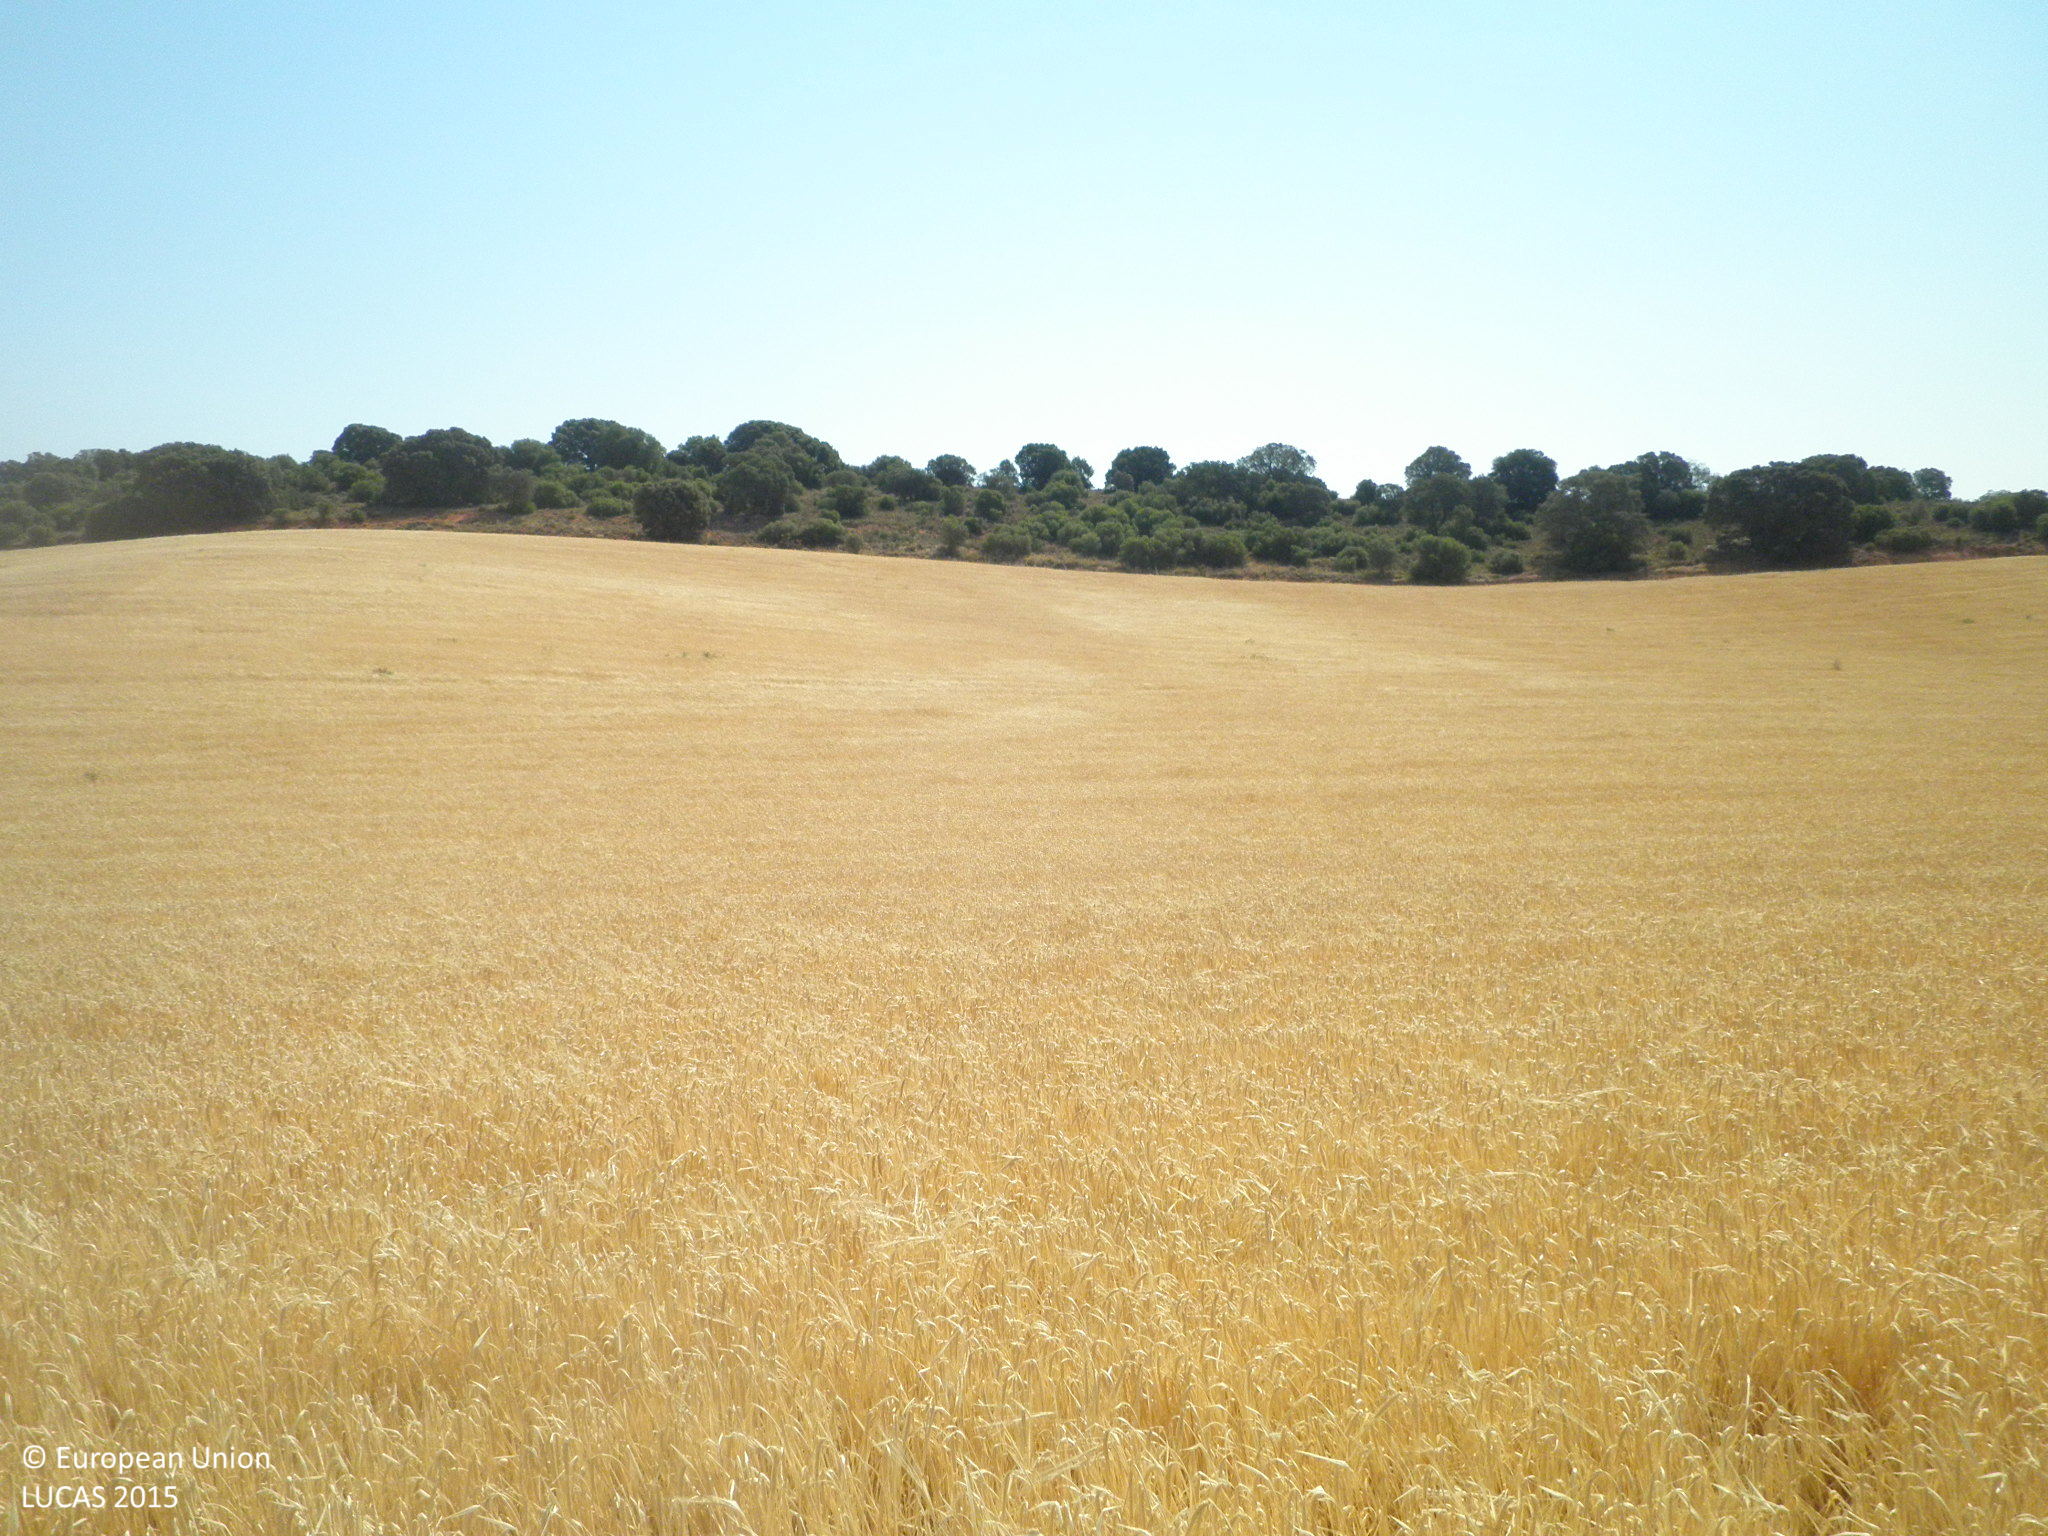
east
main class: Cropland
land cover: Barley
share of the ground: > 75 %
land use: Agriculture (excluding fallow land and kitchen gardens)
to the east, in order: Barley; Broadleaved woodland; Barley; Broadleaved woodland; Tracks; Broadleaved woodland
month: June
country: ES
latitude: 39.6510
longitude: -2.4721
